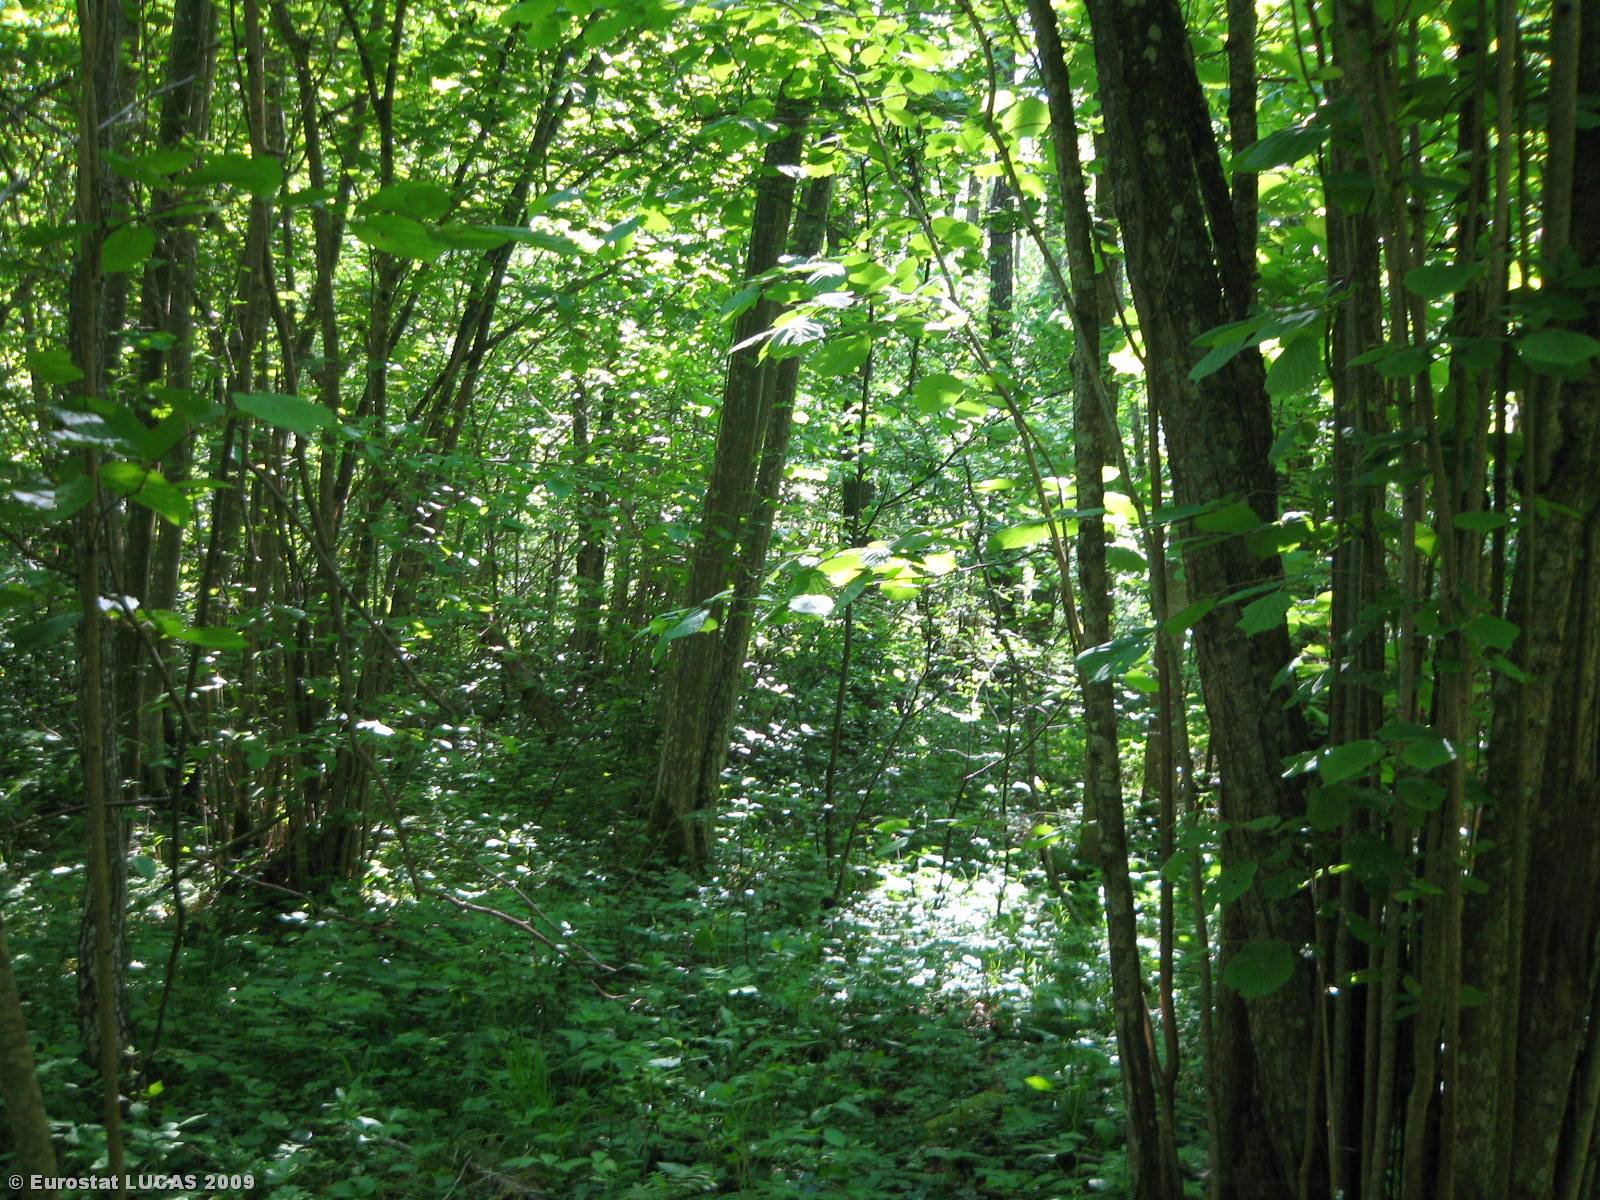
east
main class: Woodland
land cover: Broadleaved woodland
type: non-riverine alder, birch or aspen forest
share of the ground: > 75 %
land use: Forestry
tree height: > 5 m
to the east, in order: Broadleaved woodland; Shrubland with sparse tree cover
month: May
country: LT
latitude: 55.7904
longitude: 24.0765
